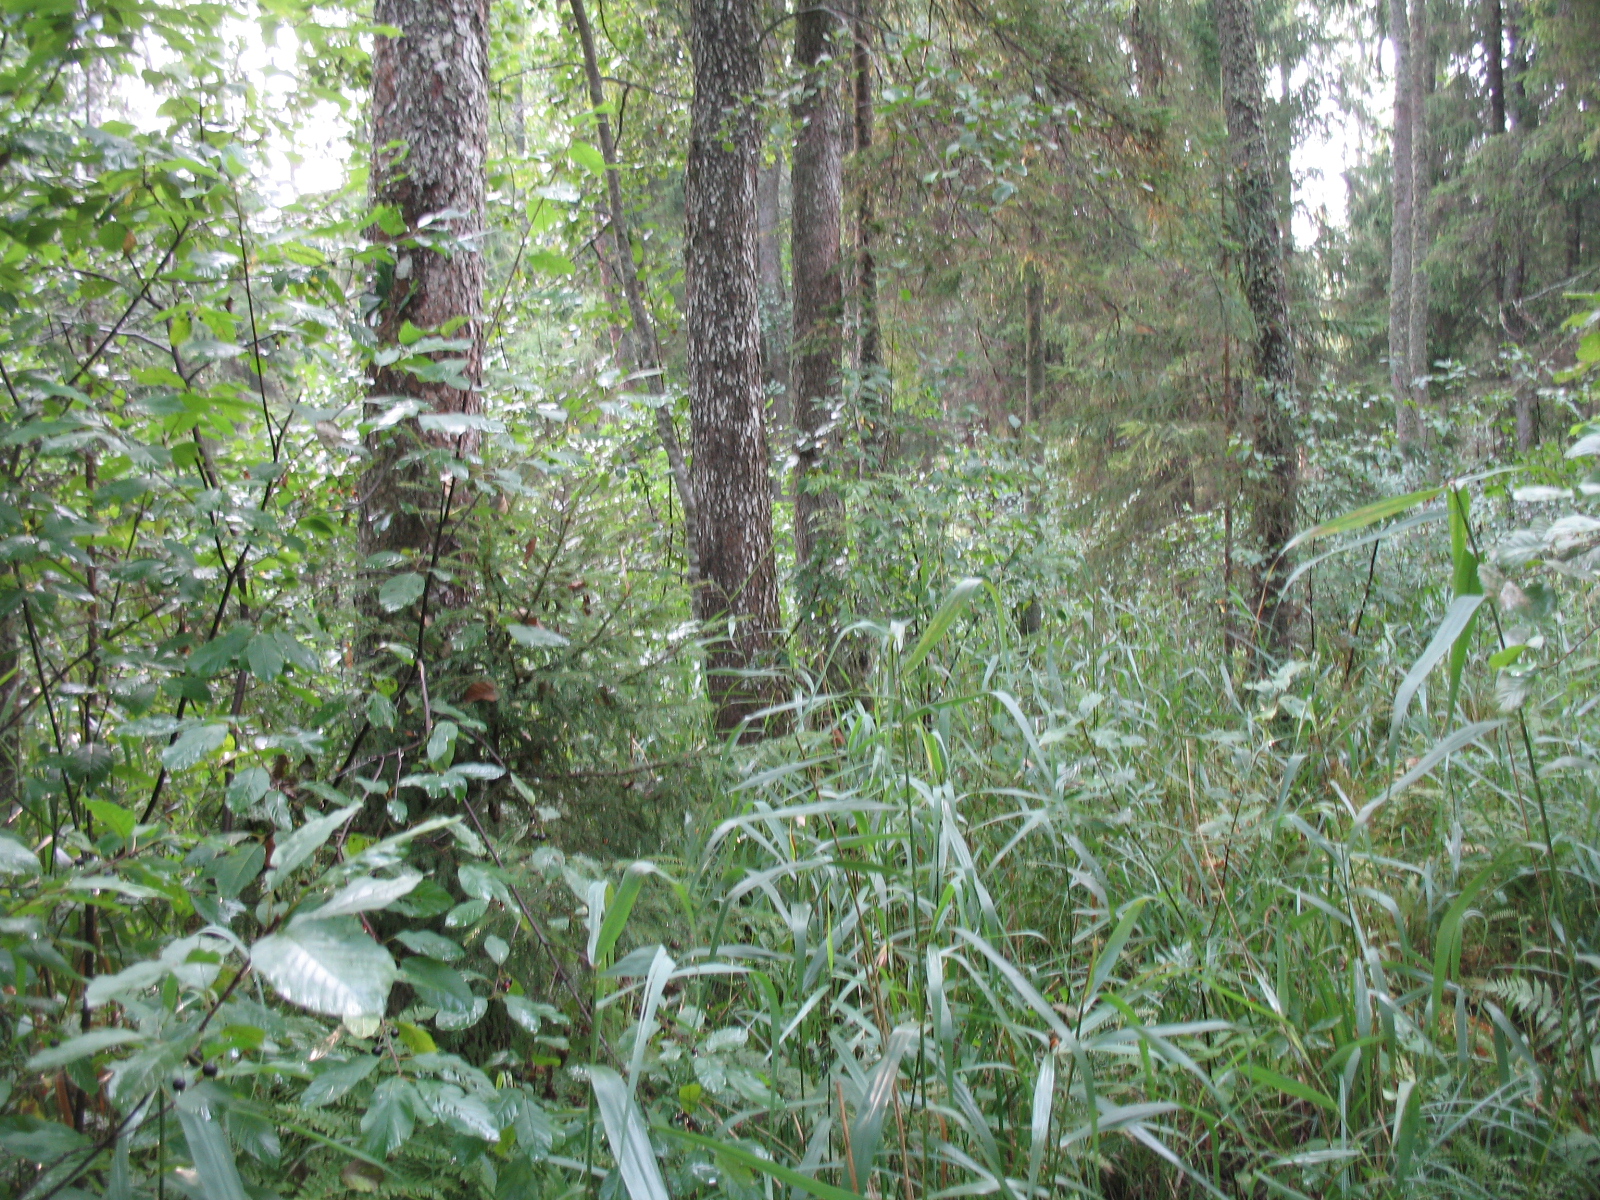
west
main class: Woodland
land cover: Broadleaved woodland
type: mire and swamp forests
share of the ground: > 75 %
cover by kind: broadleaved forest trees 75 %, herbaceous plants 15 %, coniferous forest trees 10 %
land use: Forestry
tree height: > 5 m
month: September
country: LV
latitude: 56.1601
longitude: 26.1937
